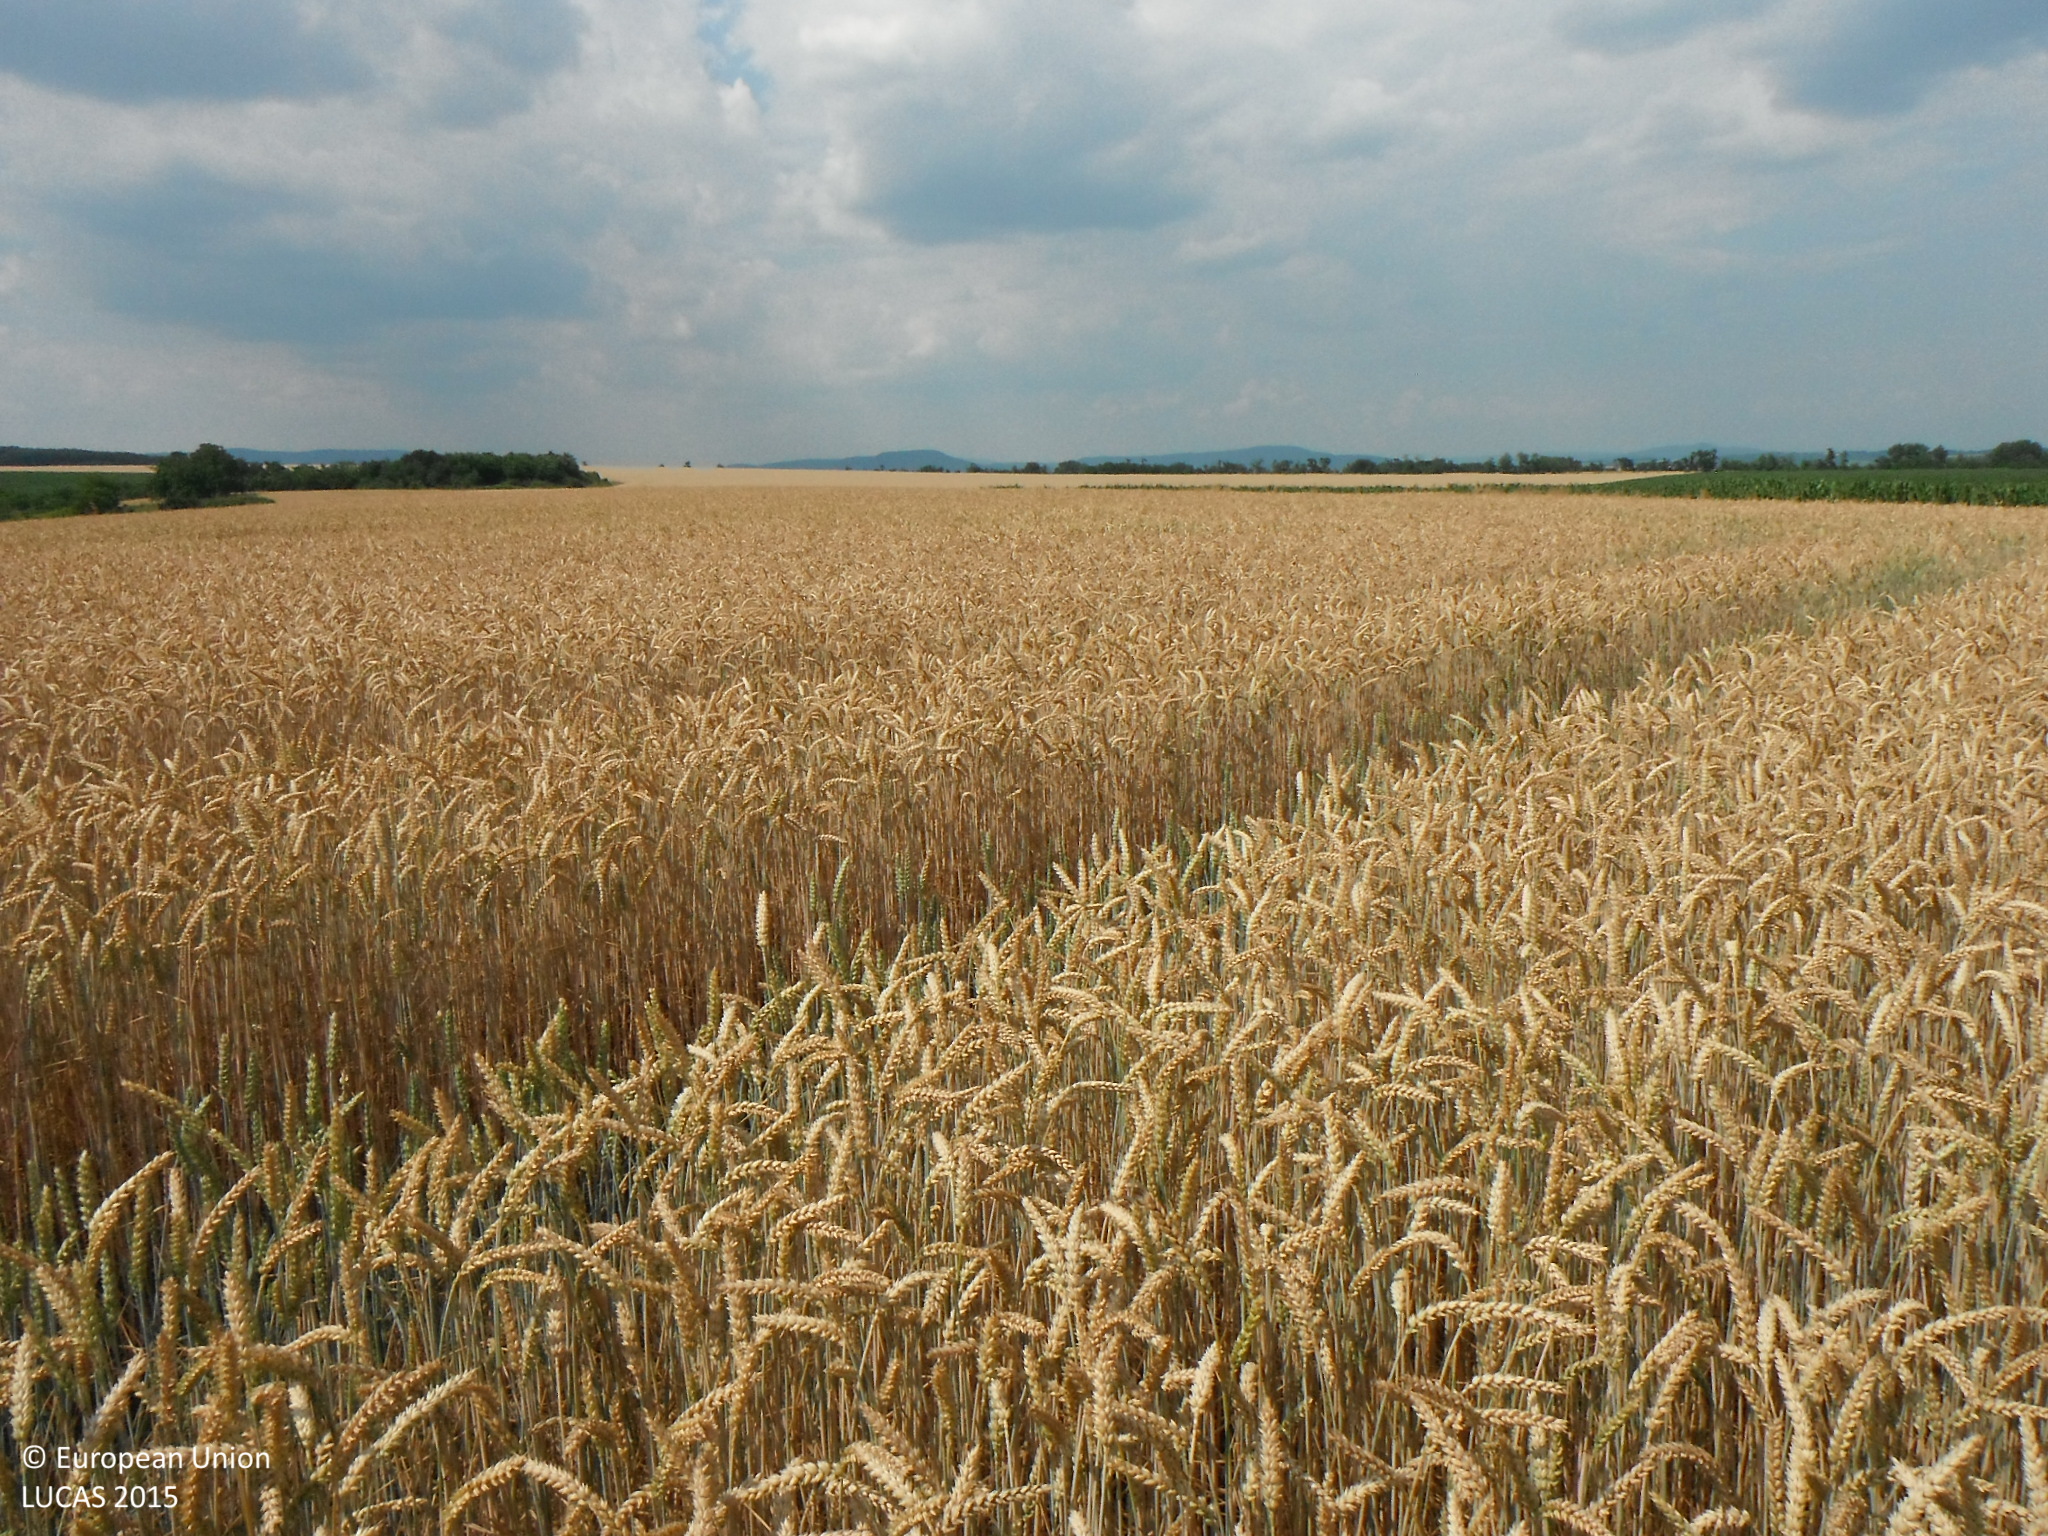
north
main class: Cropland
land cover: Common wheat
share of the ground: > 75 %
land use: Agriculture (excluding fallow land and kitchen gardens)
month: July
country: SK
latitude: 48.1168
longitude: 19.3312
